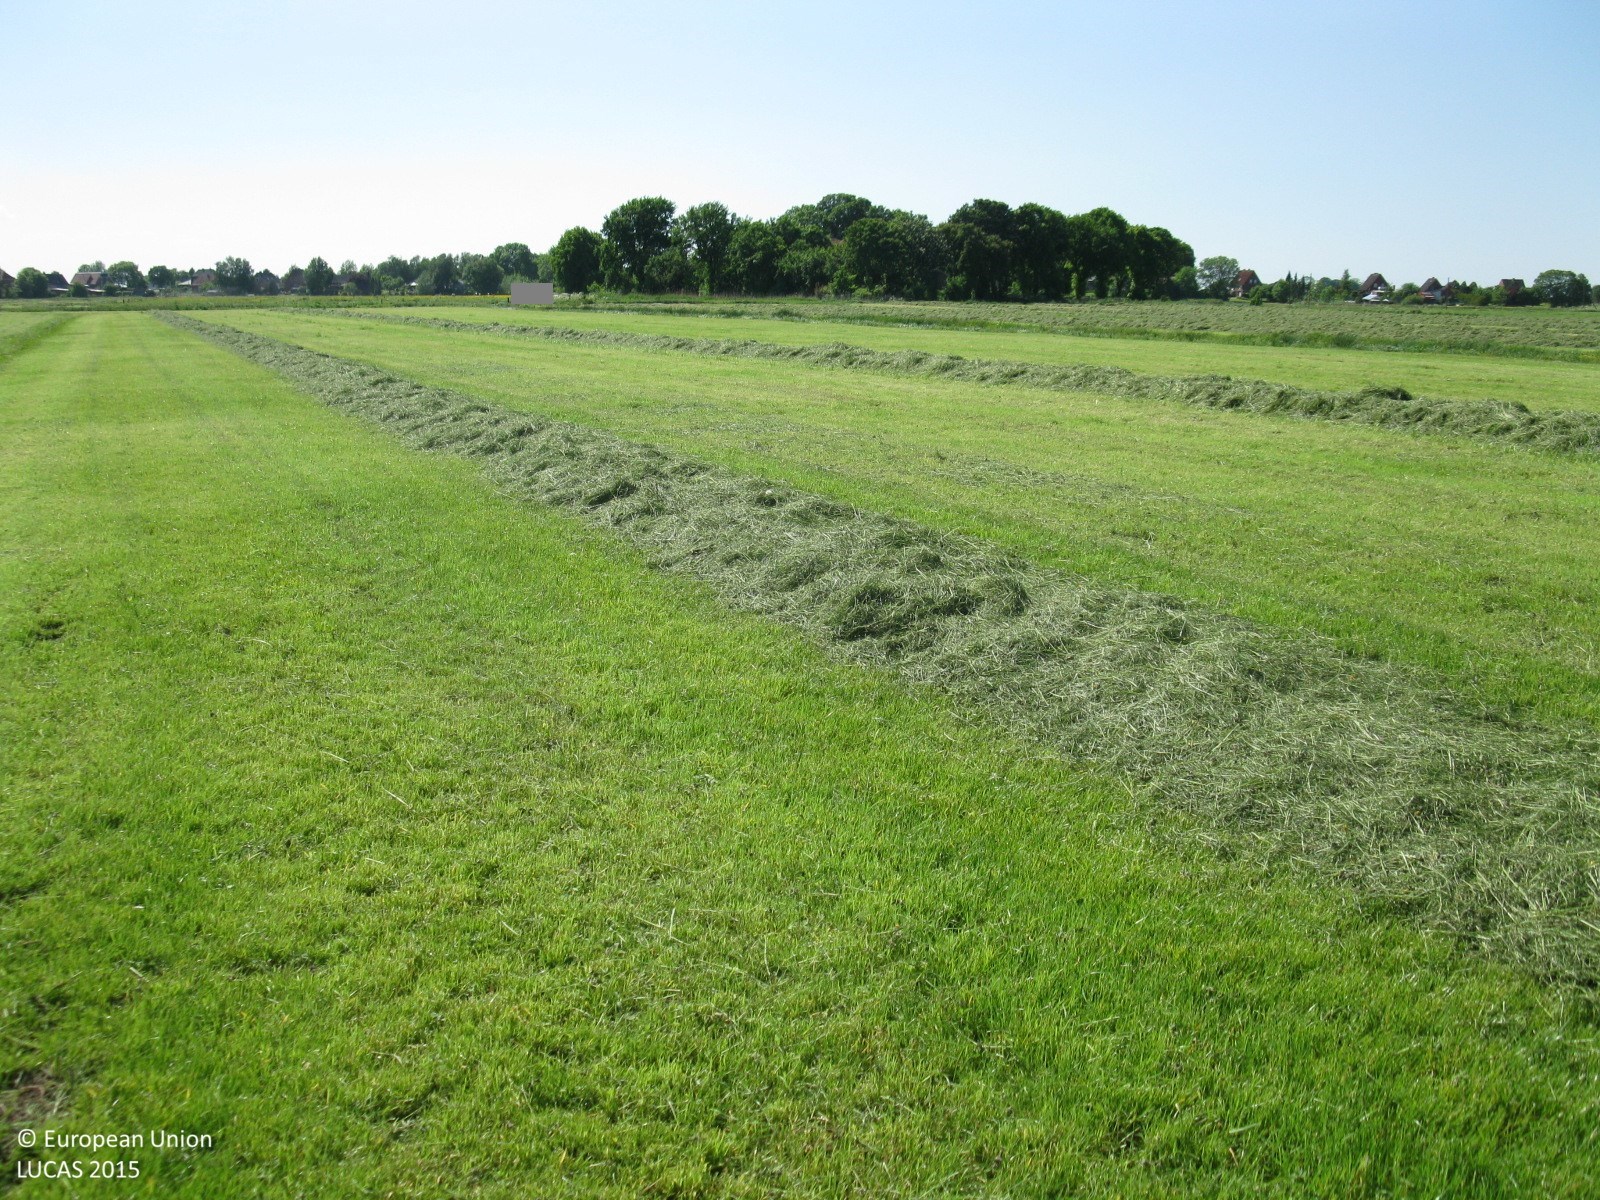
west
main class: Grassland
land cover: Grassland without tree/shrub cover
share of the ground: > 75 %
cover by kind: herbaceous plants 100 %
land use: Agriculture (excluding fallow land and kitchen gardens)
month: June
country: DE
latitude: 53.2457
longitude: 7.2881
